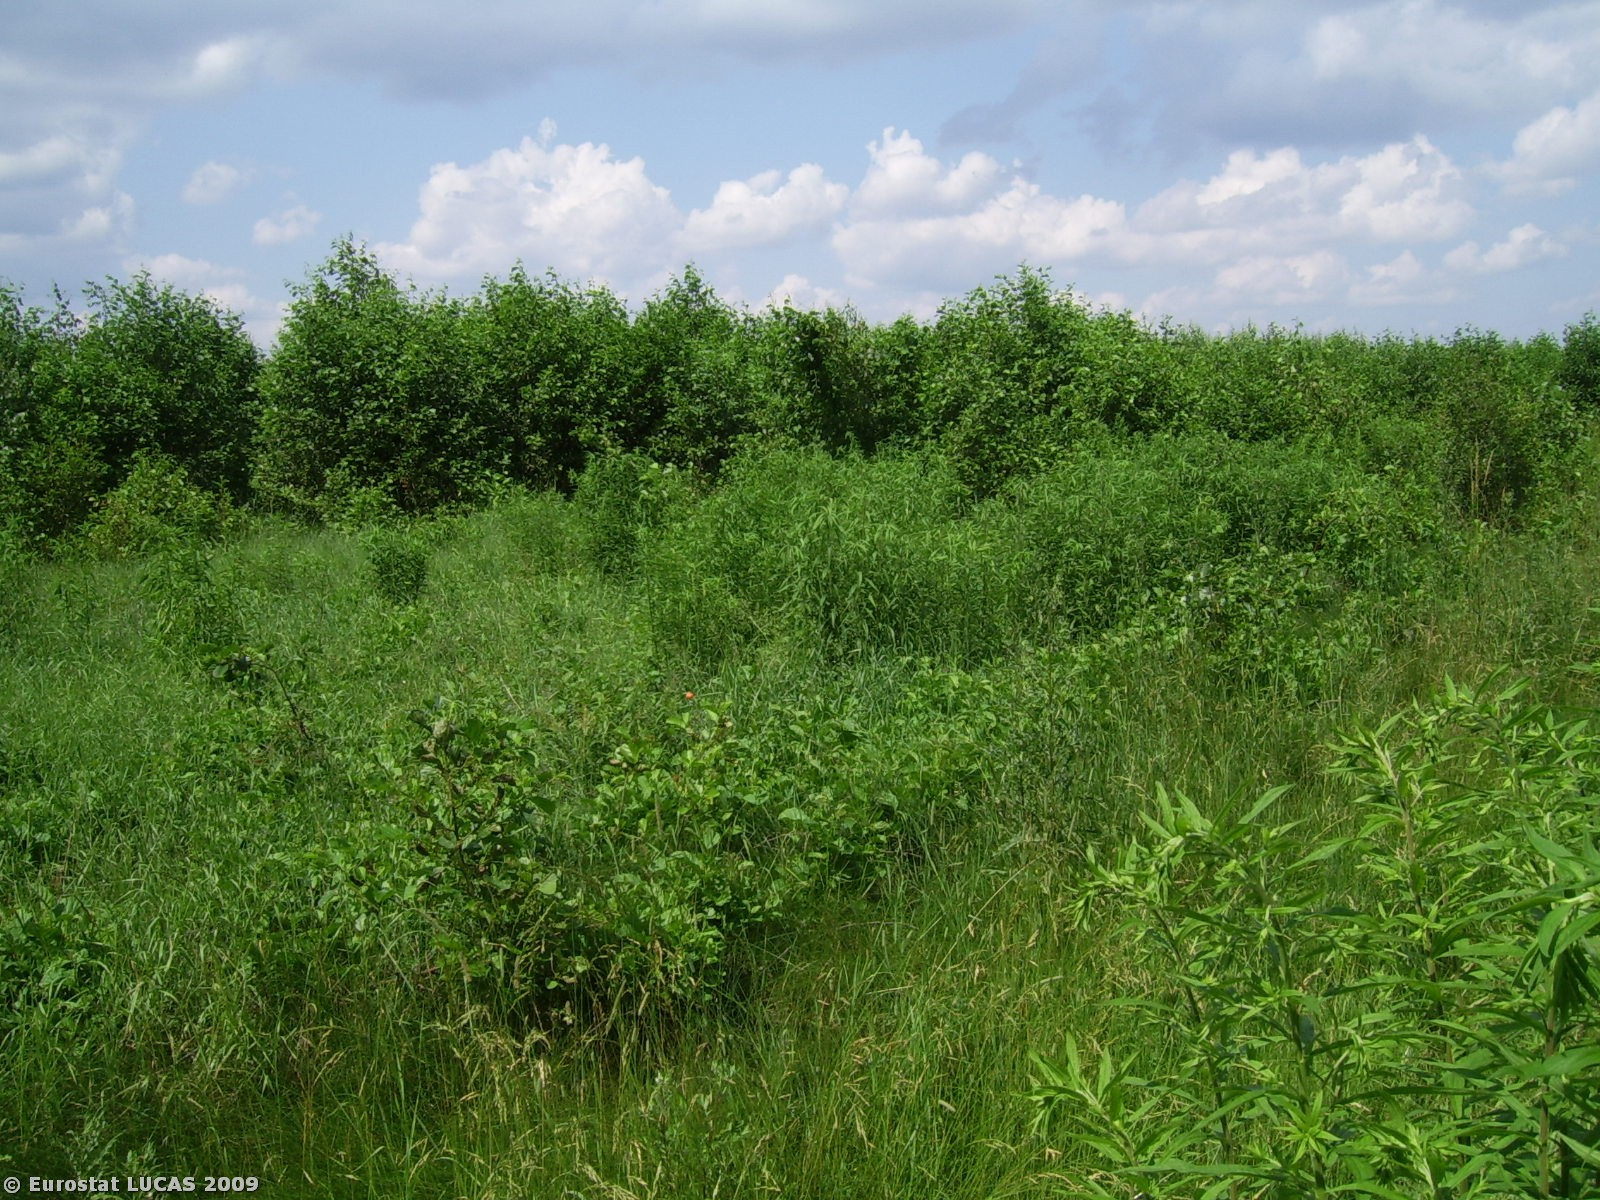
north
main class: Woodland
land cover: Broadleaved woodland
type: mesophytic deciduous forest
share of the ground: > 75 %
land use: Unused
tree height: > 5 m
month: July
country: PL
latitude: 53.2056
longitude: 18.0553
